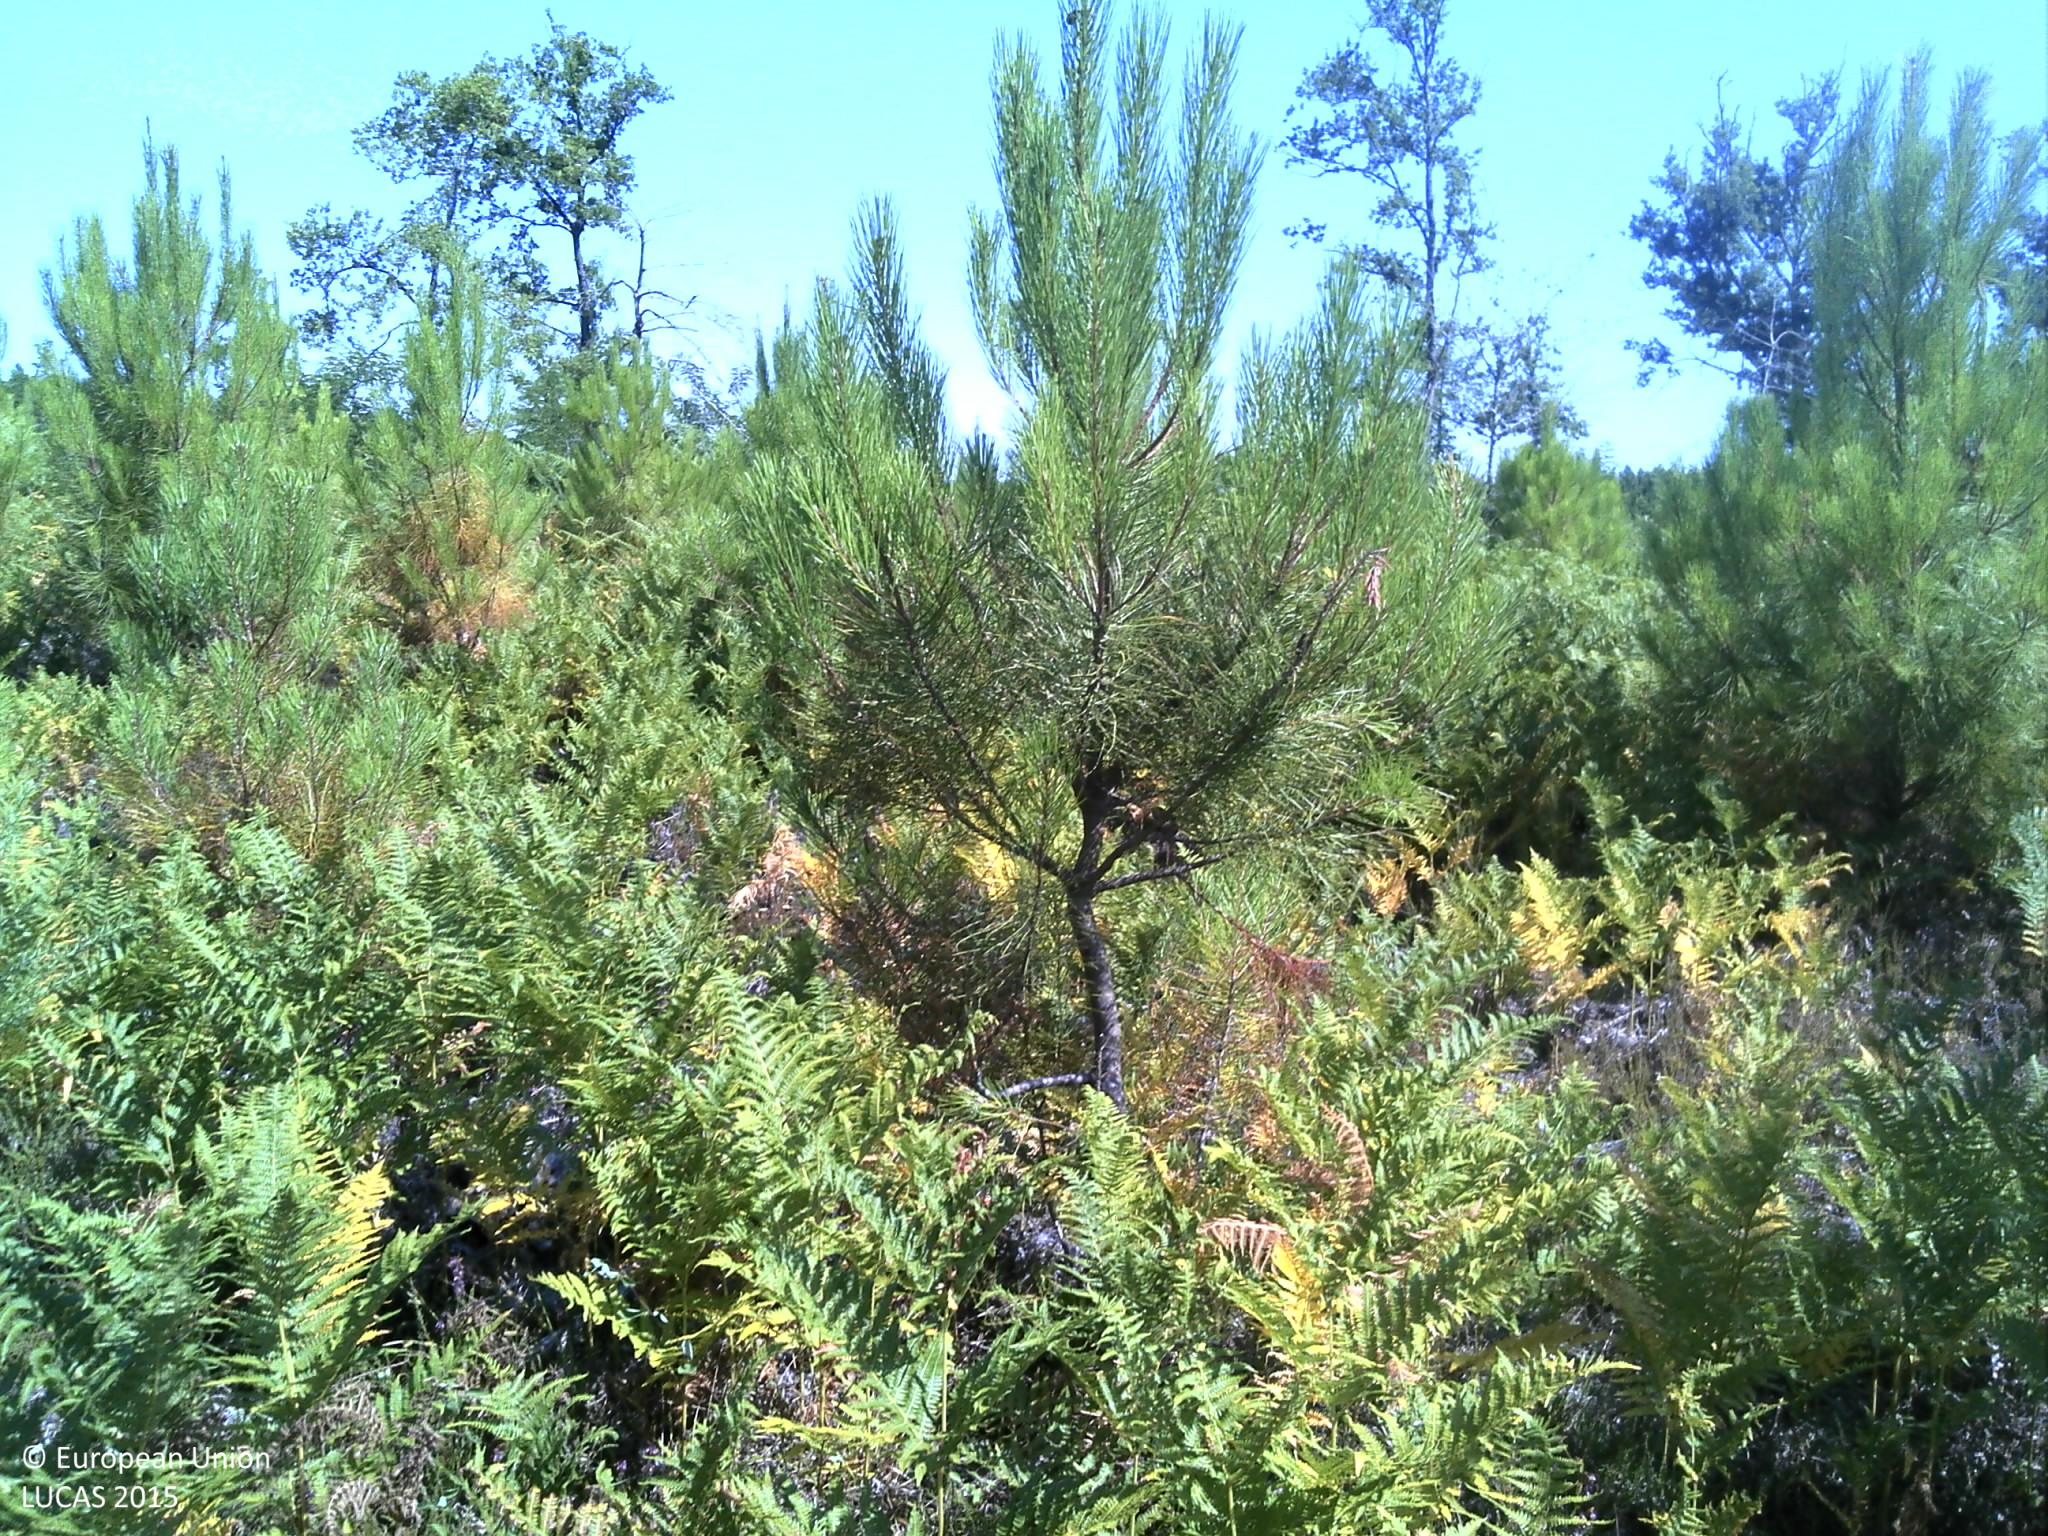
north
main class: Shrubland
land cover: Shrubland with sparse tree cover
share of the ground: > 75 %
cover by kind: shrubs 85 %, coniferous forest trees 5 %, herbaceous plants 5 %, lichens and mosses 5 %
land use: Semi-natural and natural areas not in use
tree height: < 5 m
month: July
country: FR
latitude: 44.3928
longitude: -0.3710
